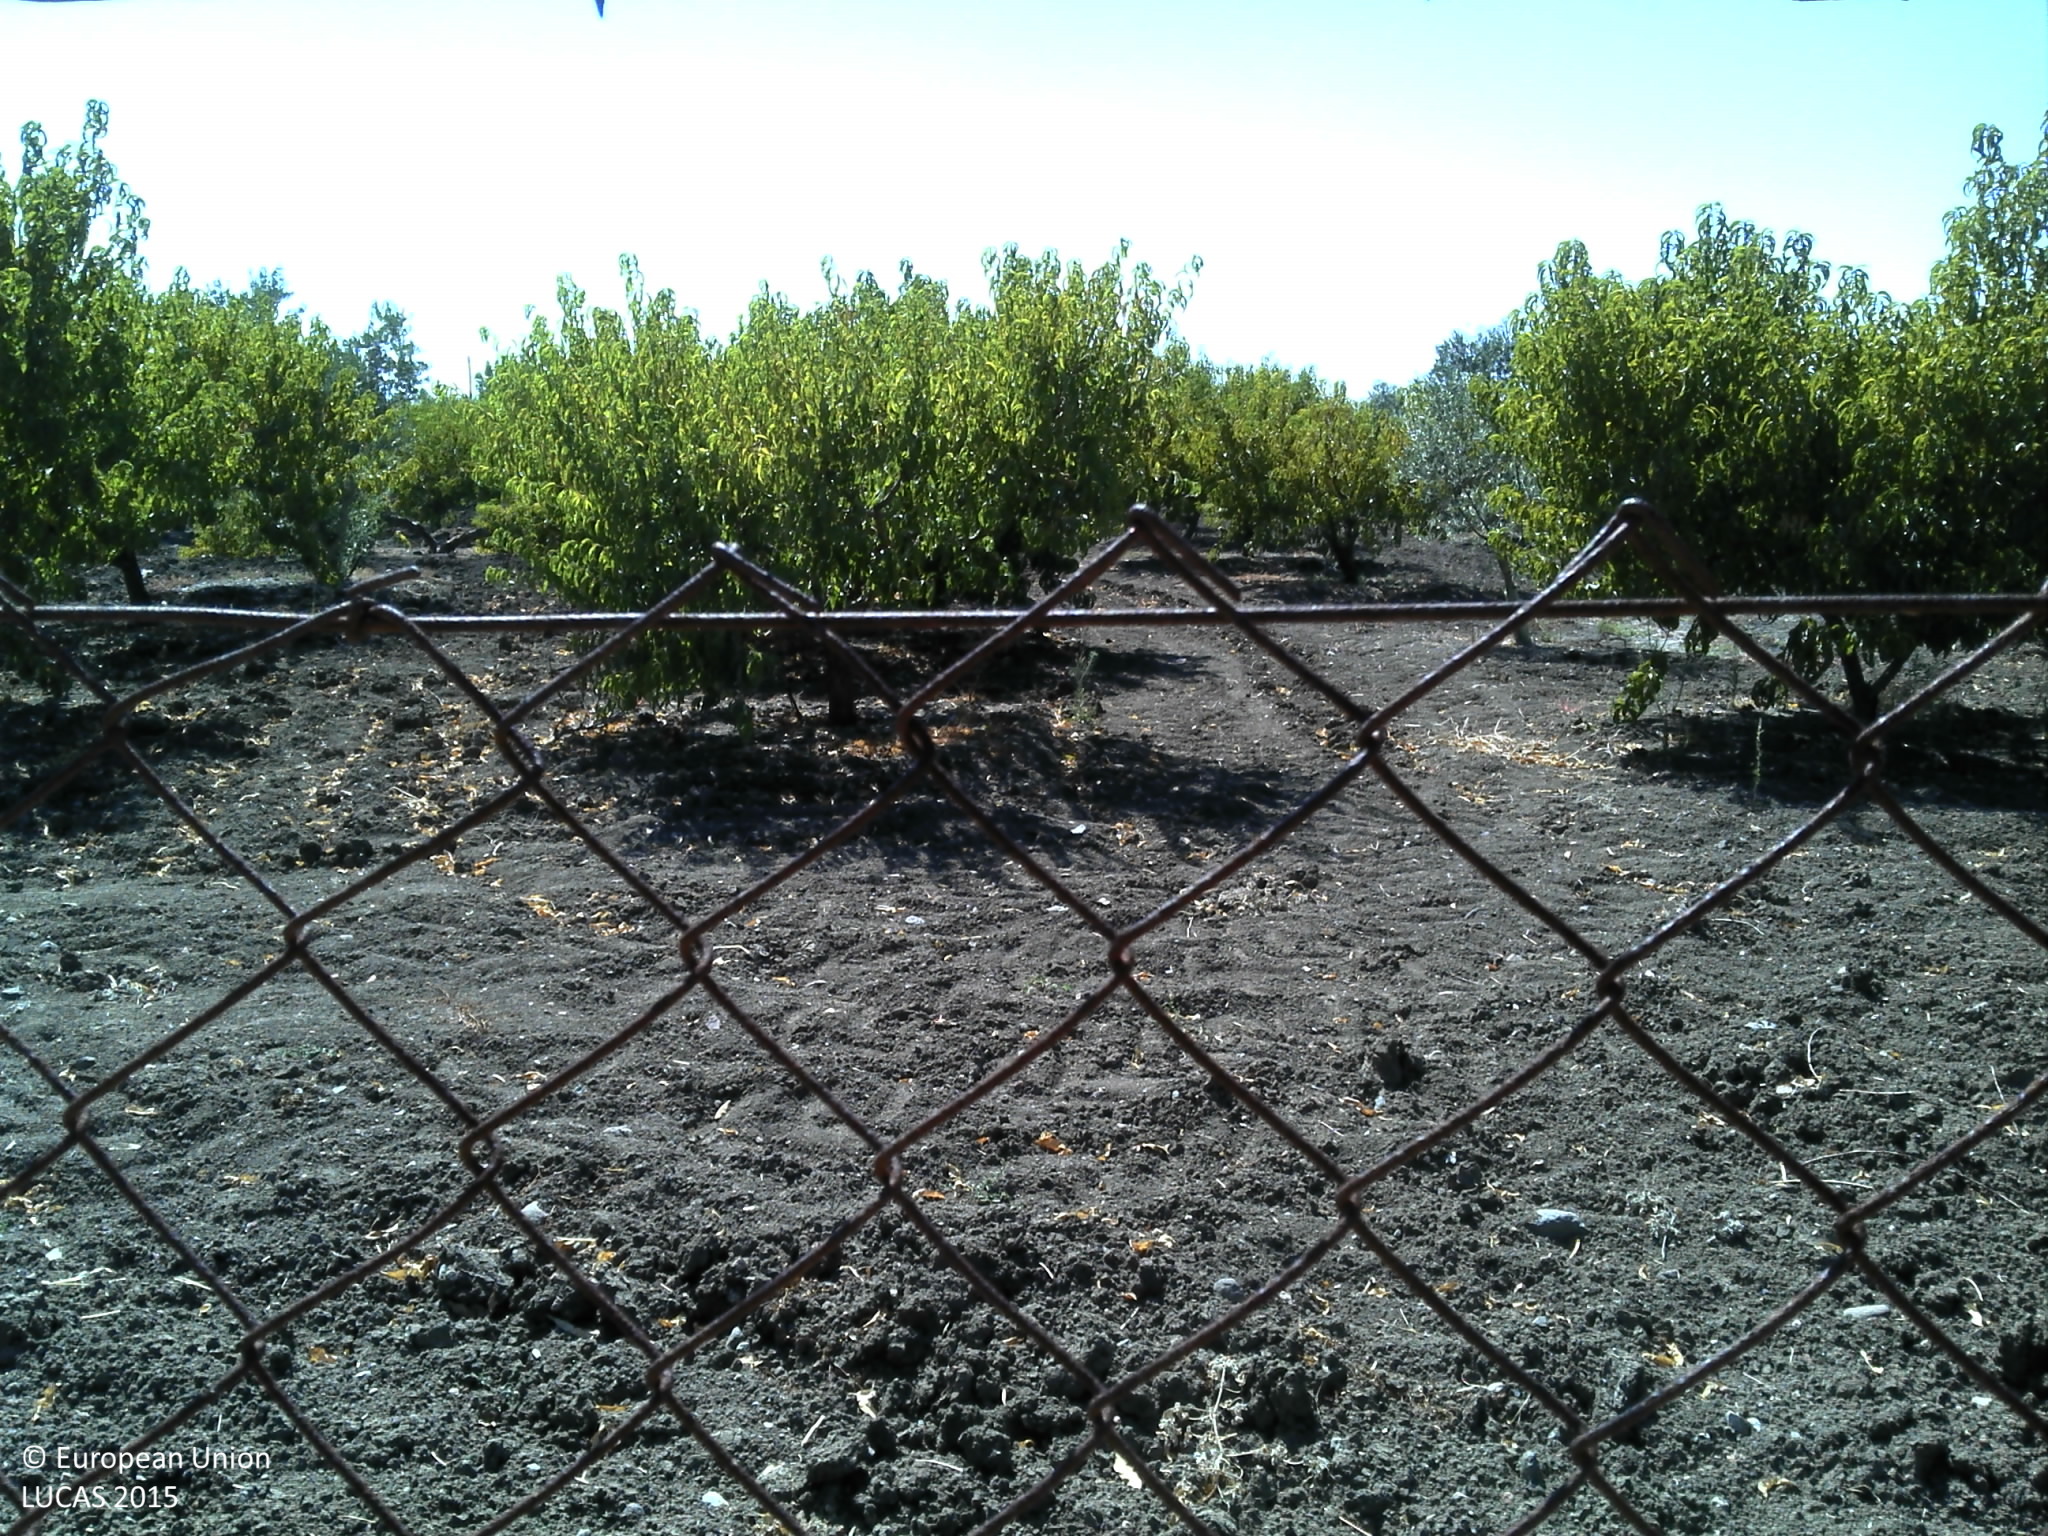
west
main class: Cropland
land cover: Other fruit trees and berries
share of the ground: 50 - 75 %
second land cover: Other bare soil
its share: > 75 %
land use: Agriculture (excluding fallow land and kitchen gardens)
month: August
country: PT
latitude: 38.0186
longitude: -7.8775
